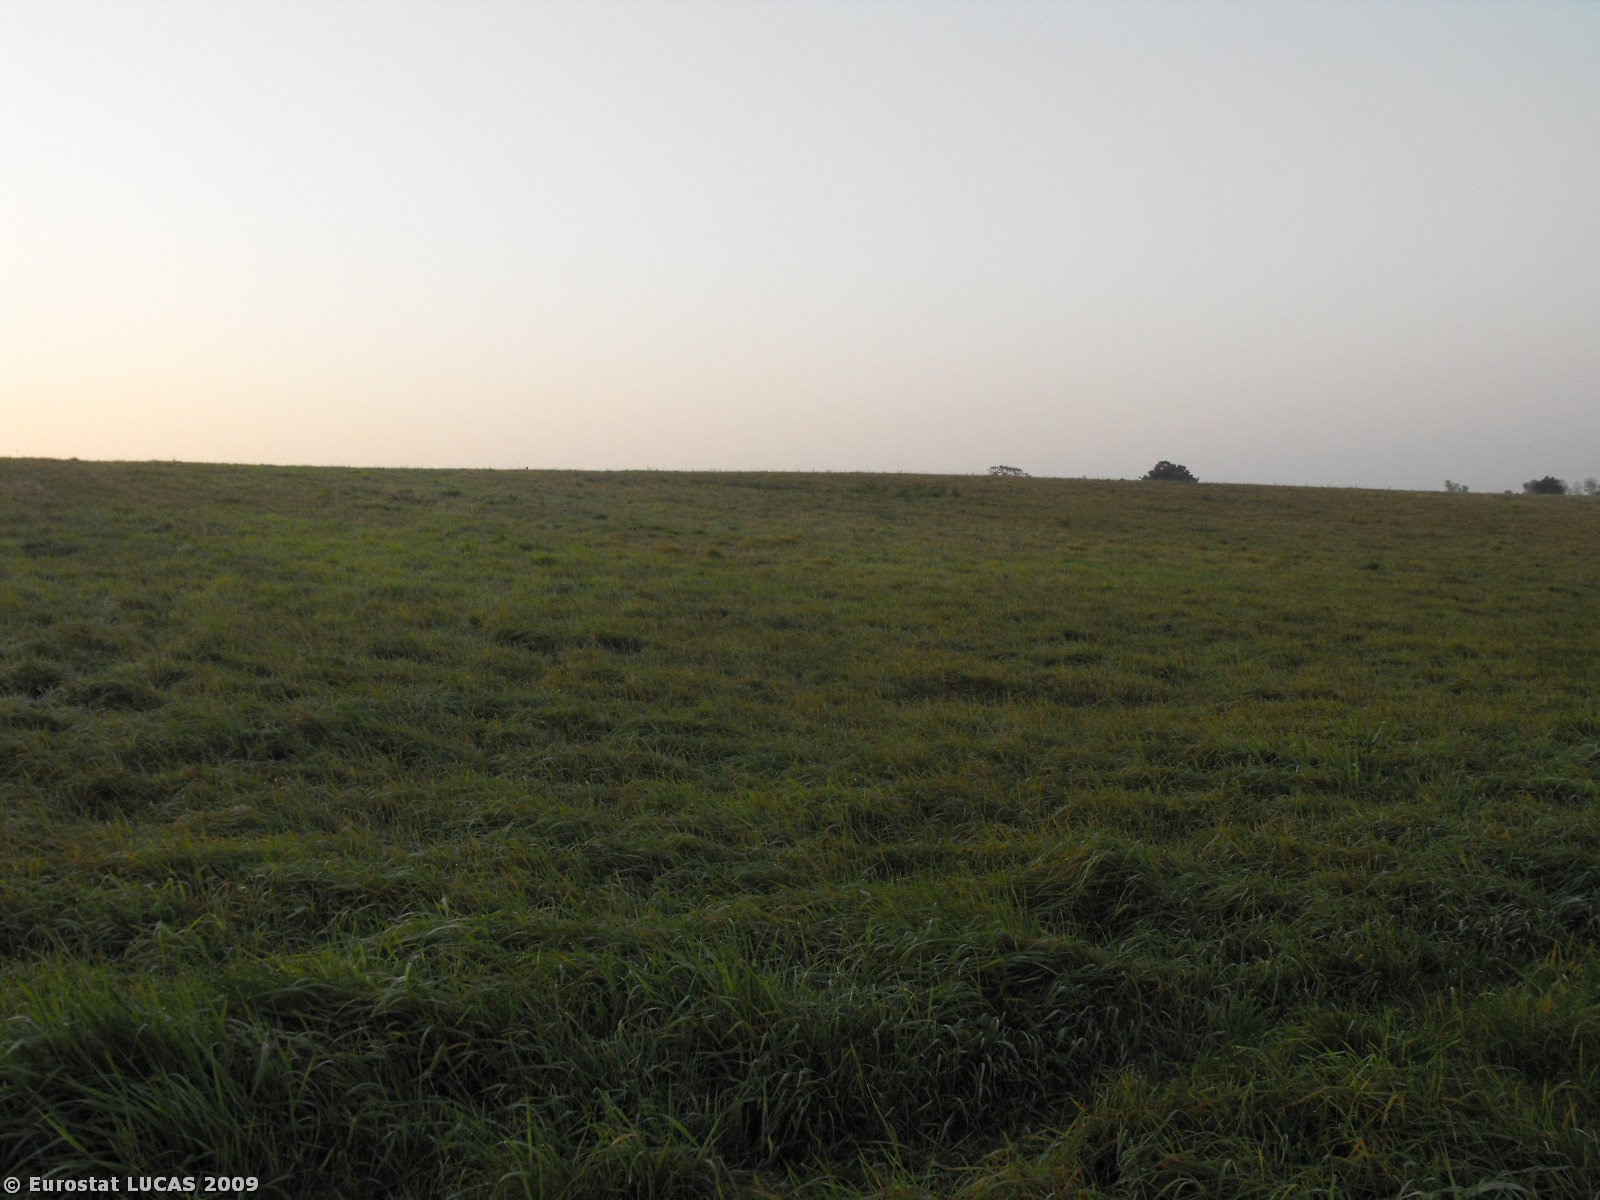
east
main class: Grassland
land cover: Spontaneously vegetated surfaces
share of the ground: > 75 %
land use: Unused
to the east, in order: Spontaneously vegetated surfaces
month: September
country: PL
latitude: 54.4585
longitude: 16.7478
